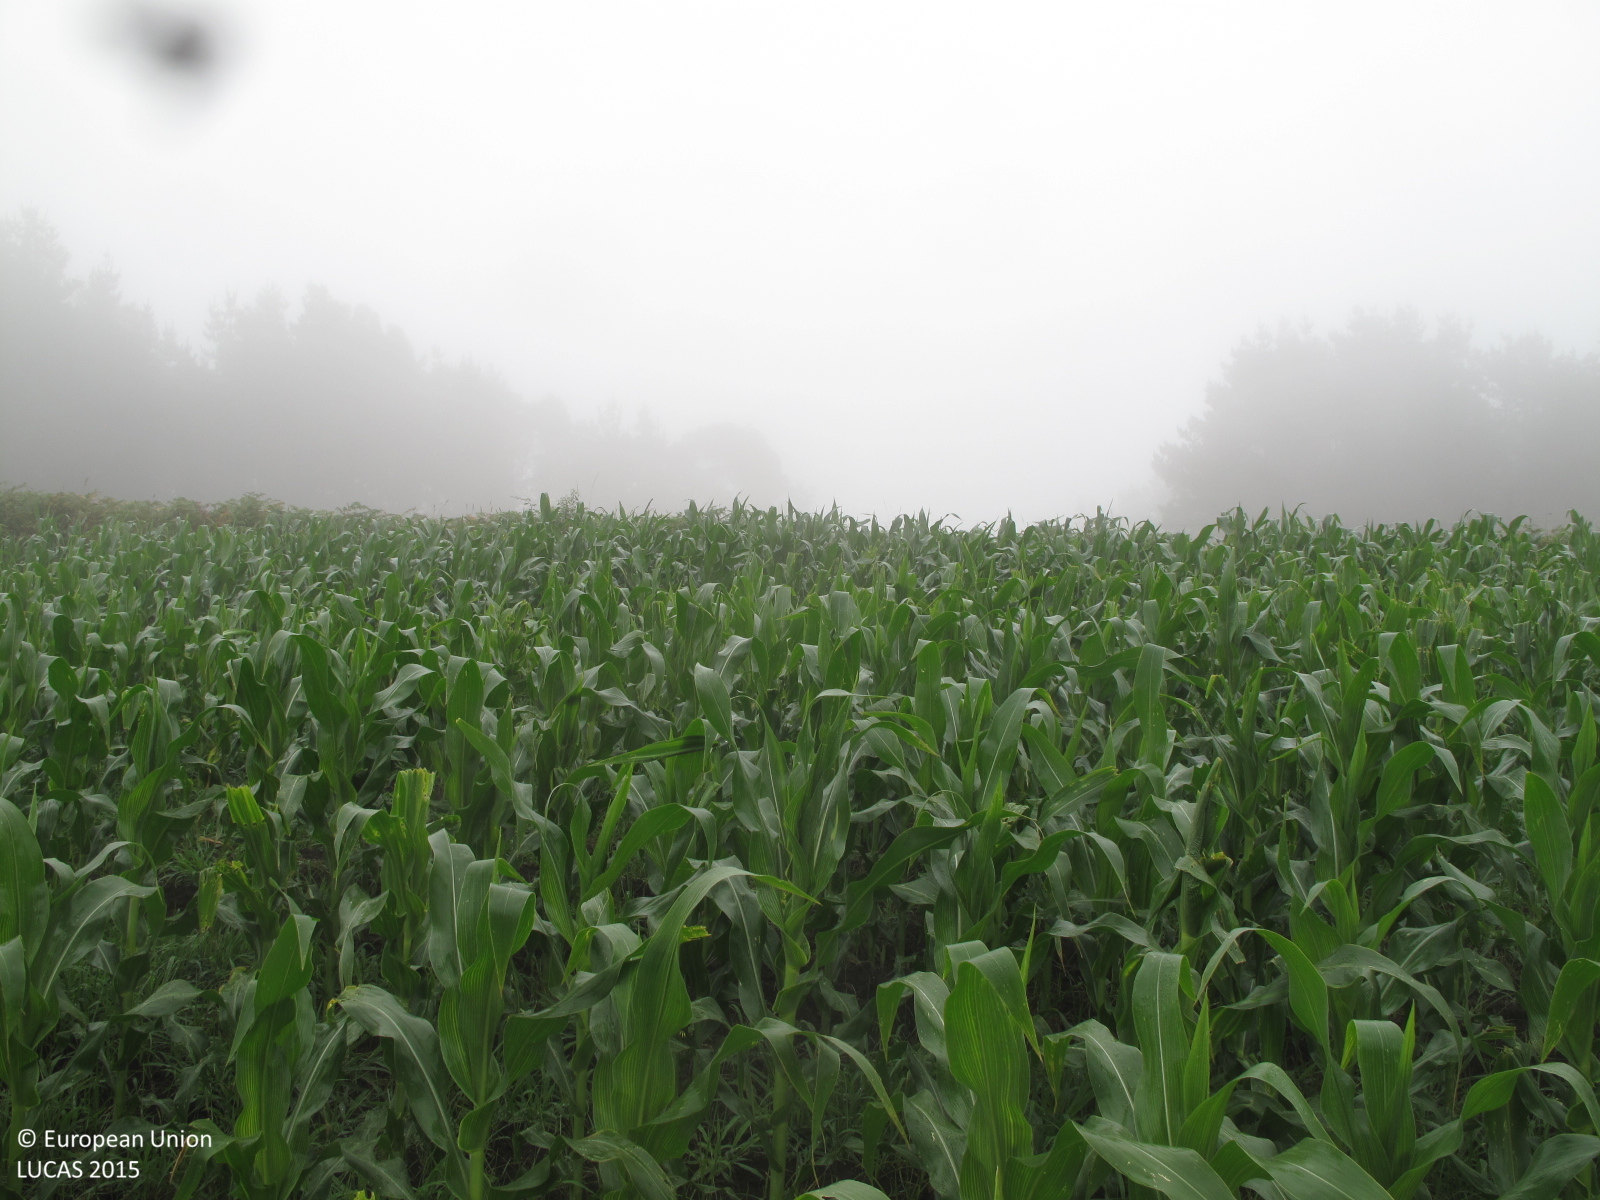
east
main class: Cropland
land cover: Maize
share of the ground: 50 - 75 %
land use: Agriculture (excluding fallow land and kitchen gardens)
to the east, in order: Maize; Shruby margins; Tracks; Grassland without tree/shrub cover; Dry stone walls; Pine dominated coniferous woodland; Broadleaved woodland; Dry stone walls; Broadleaved woodland
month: July
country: ES
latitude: 43.0417
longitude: -9.2675
